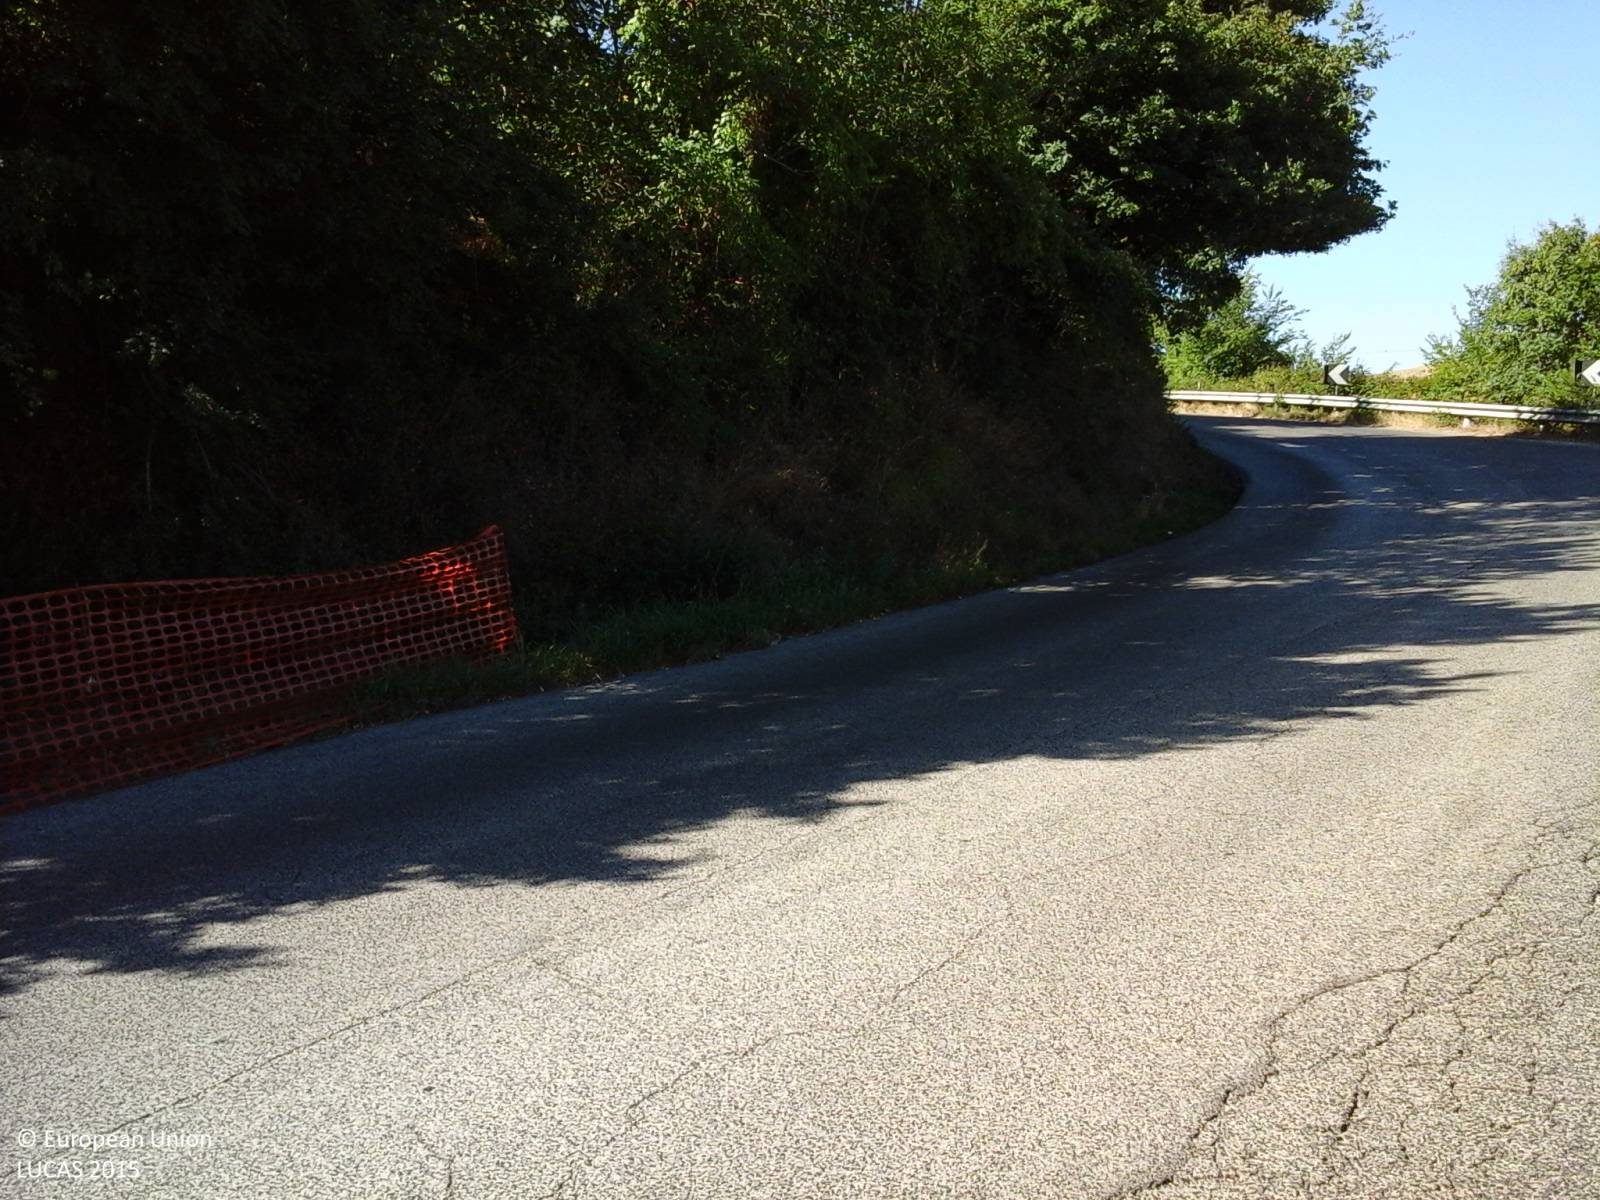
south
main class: Grassland
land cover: Grassland without tree/shrub cover
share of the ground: > 75 %
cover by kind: herbaceous plants 100 %
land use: Agriculture (excluding fallow land and kitchen gardens)
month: July
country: IT
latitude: 42.1365
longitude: 12.4473
